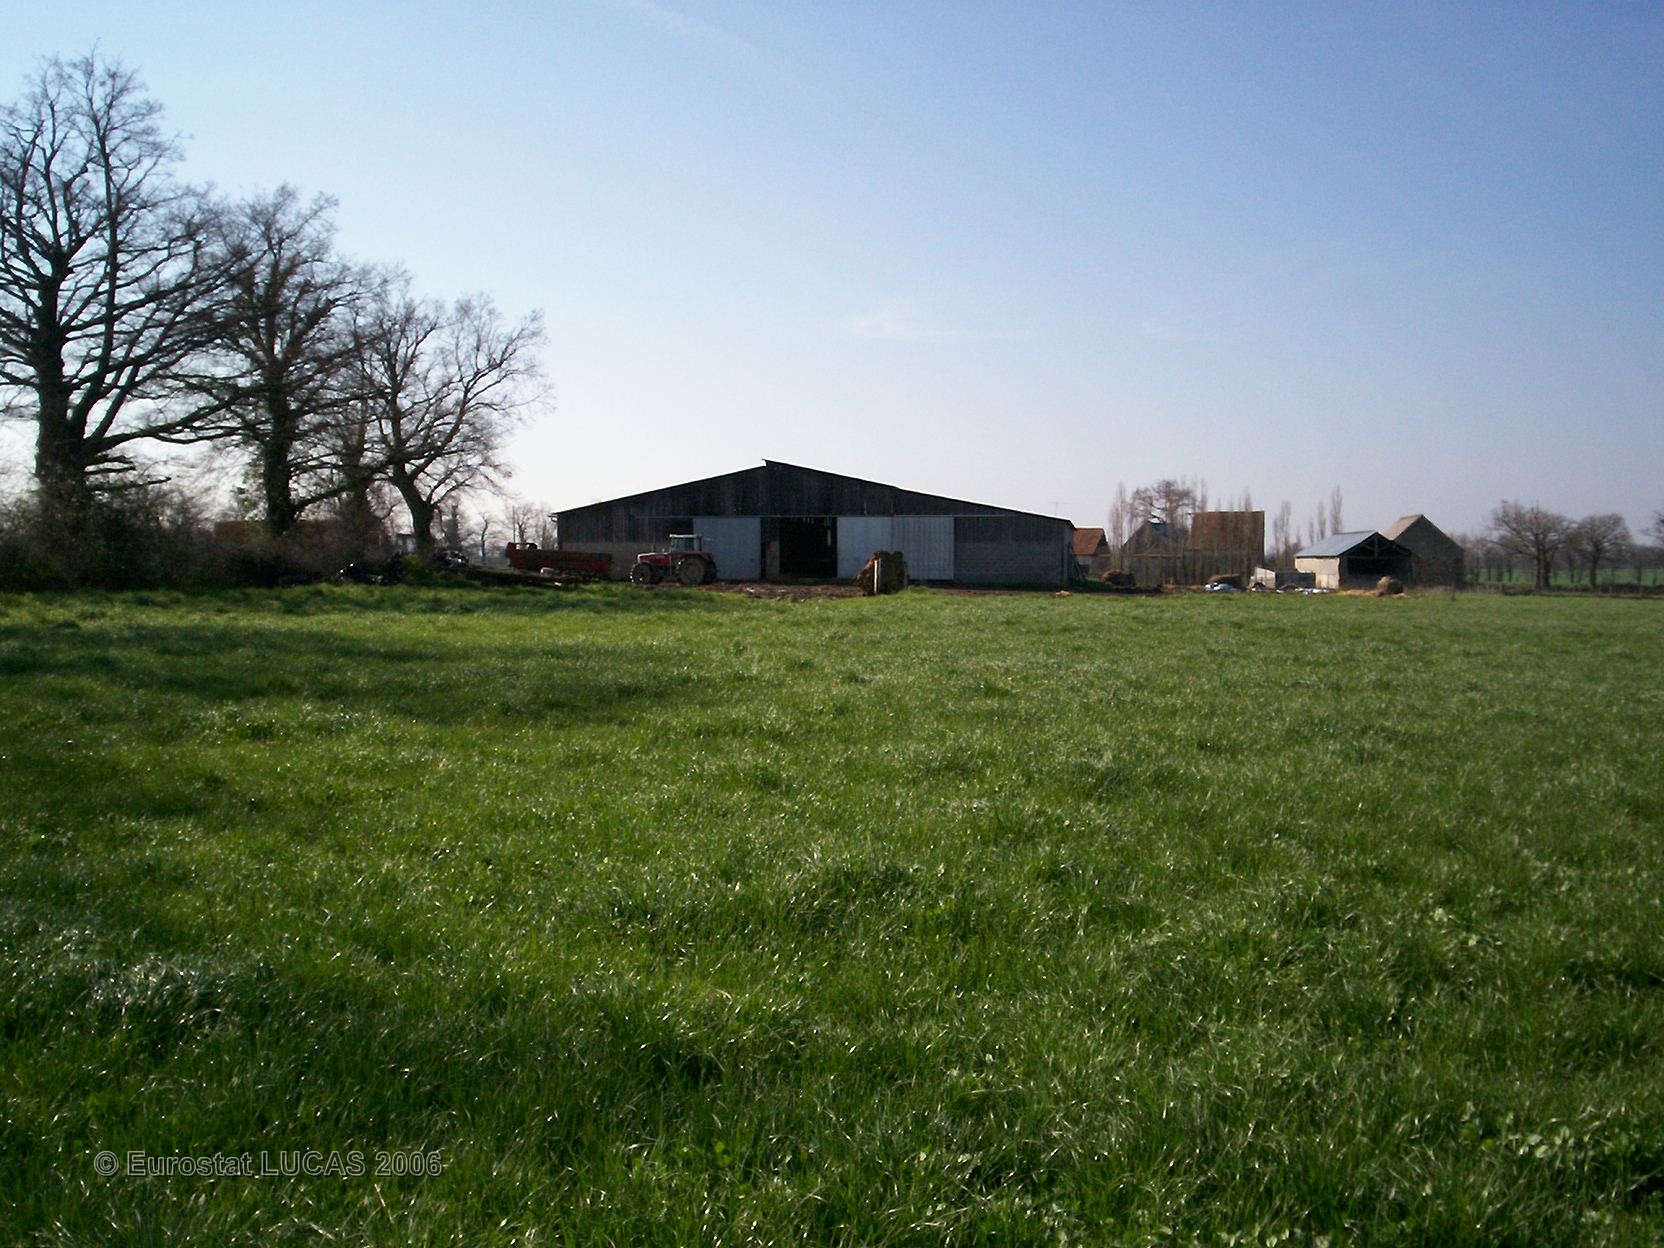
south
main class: Grassland
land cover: Grassland without tree/shrub cover
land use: Agriculture (excluding fallow land and kitchen gardens)
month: April
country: FR
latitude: 46.3588
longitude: 1.0848
